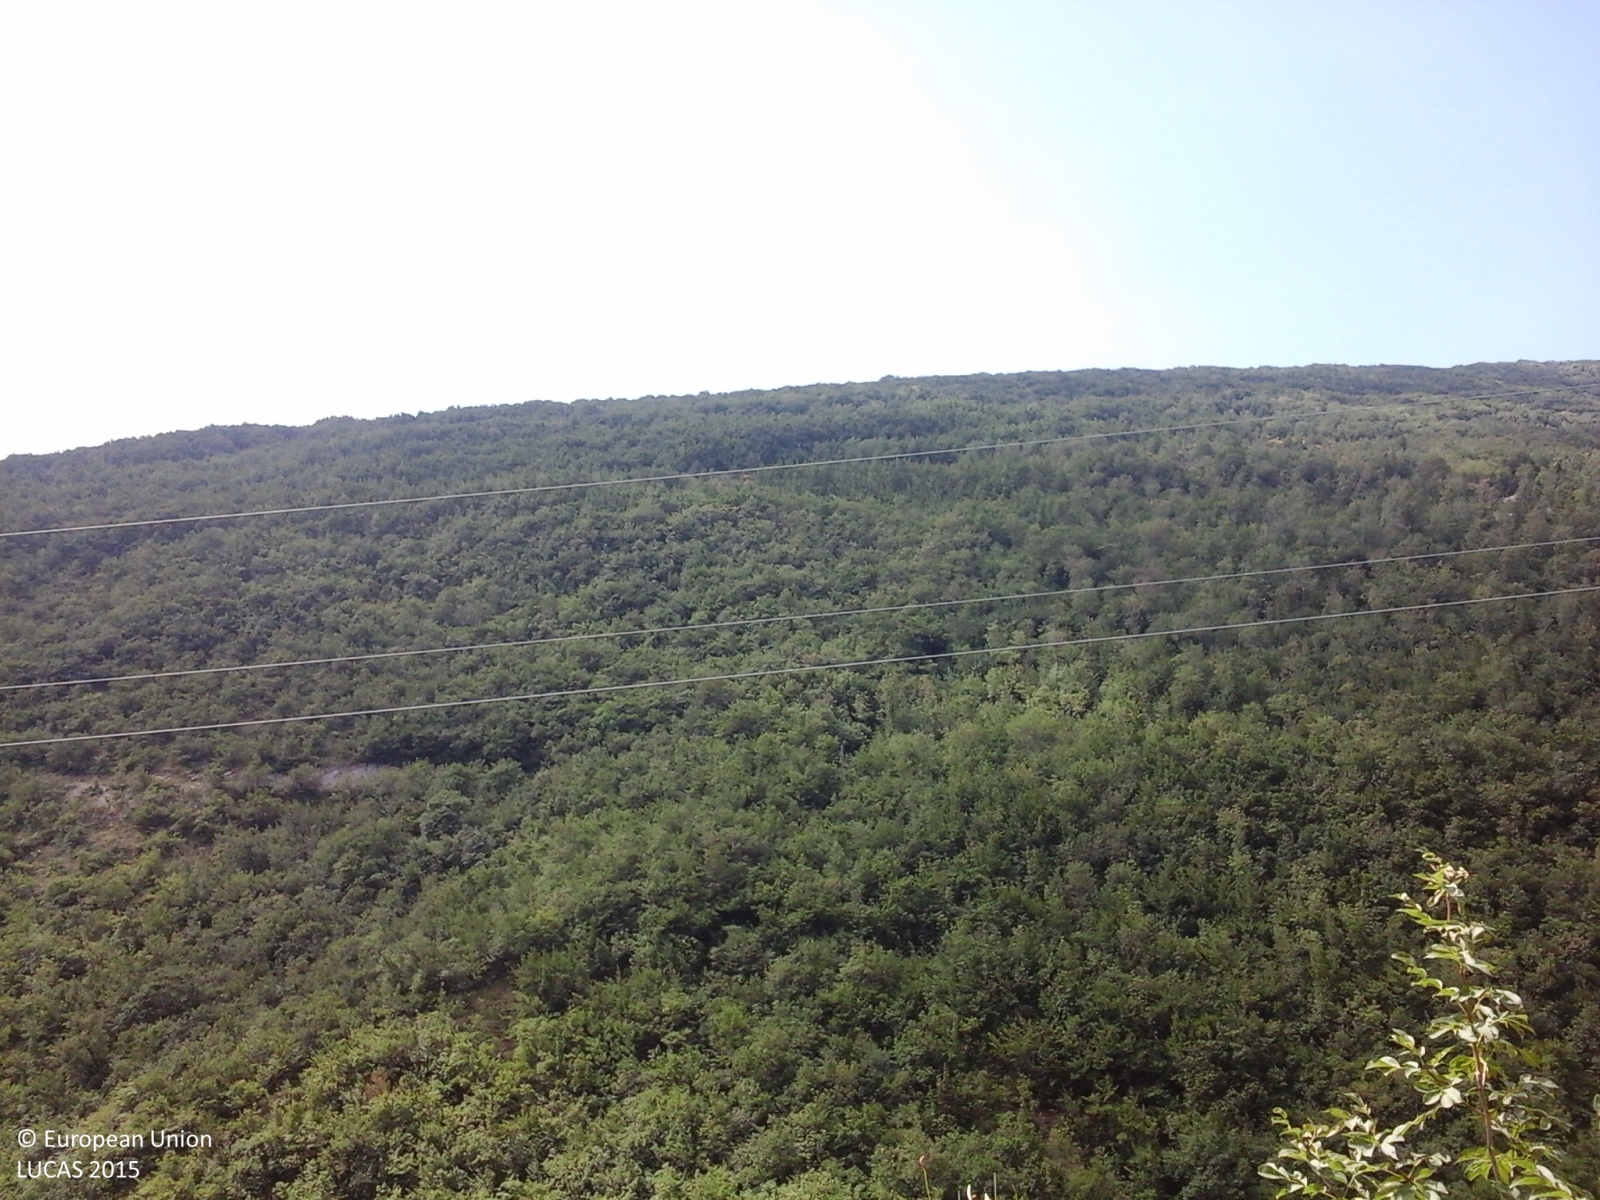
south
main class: Woodland
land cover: Broadleaved woodland
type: thermophilous deciduous forest
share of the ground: > 75 %
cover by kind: broadleaved forest trees 90 %, shrubs 10 %
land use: Forestry
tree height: > 5 m
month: June
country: IT
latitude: 43.1824
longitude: 13.1779
